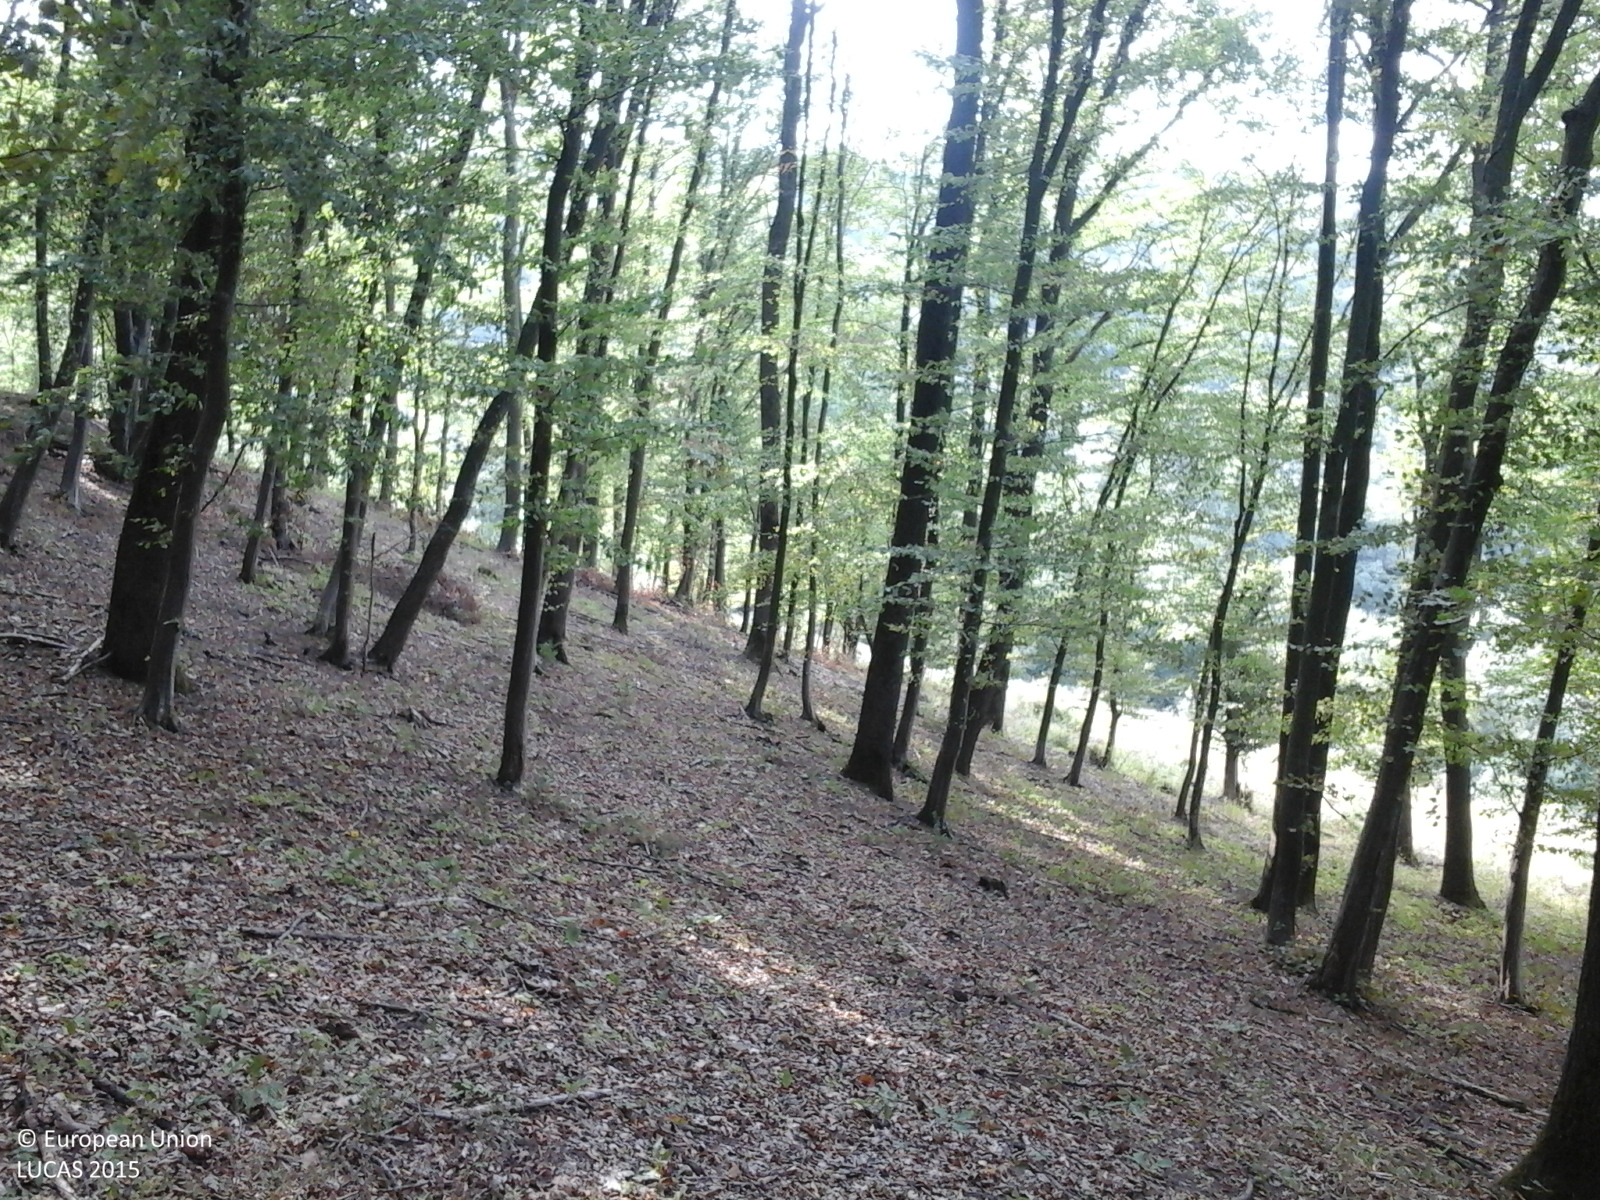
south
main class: Woodland
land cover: Broadleaved woodland
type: acidophilous oak and oak-birch forest
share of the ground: > 75 %
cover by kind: broadleaved forest trees 100 %
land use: Forestry
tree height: > 5 m
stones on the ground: < 10 %
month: September
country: RO
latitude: 45.9387
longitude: 22.8353
